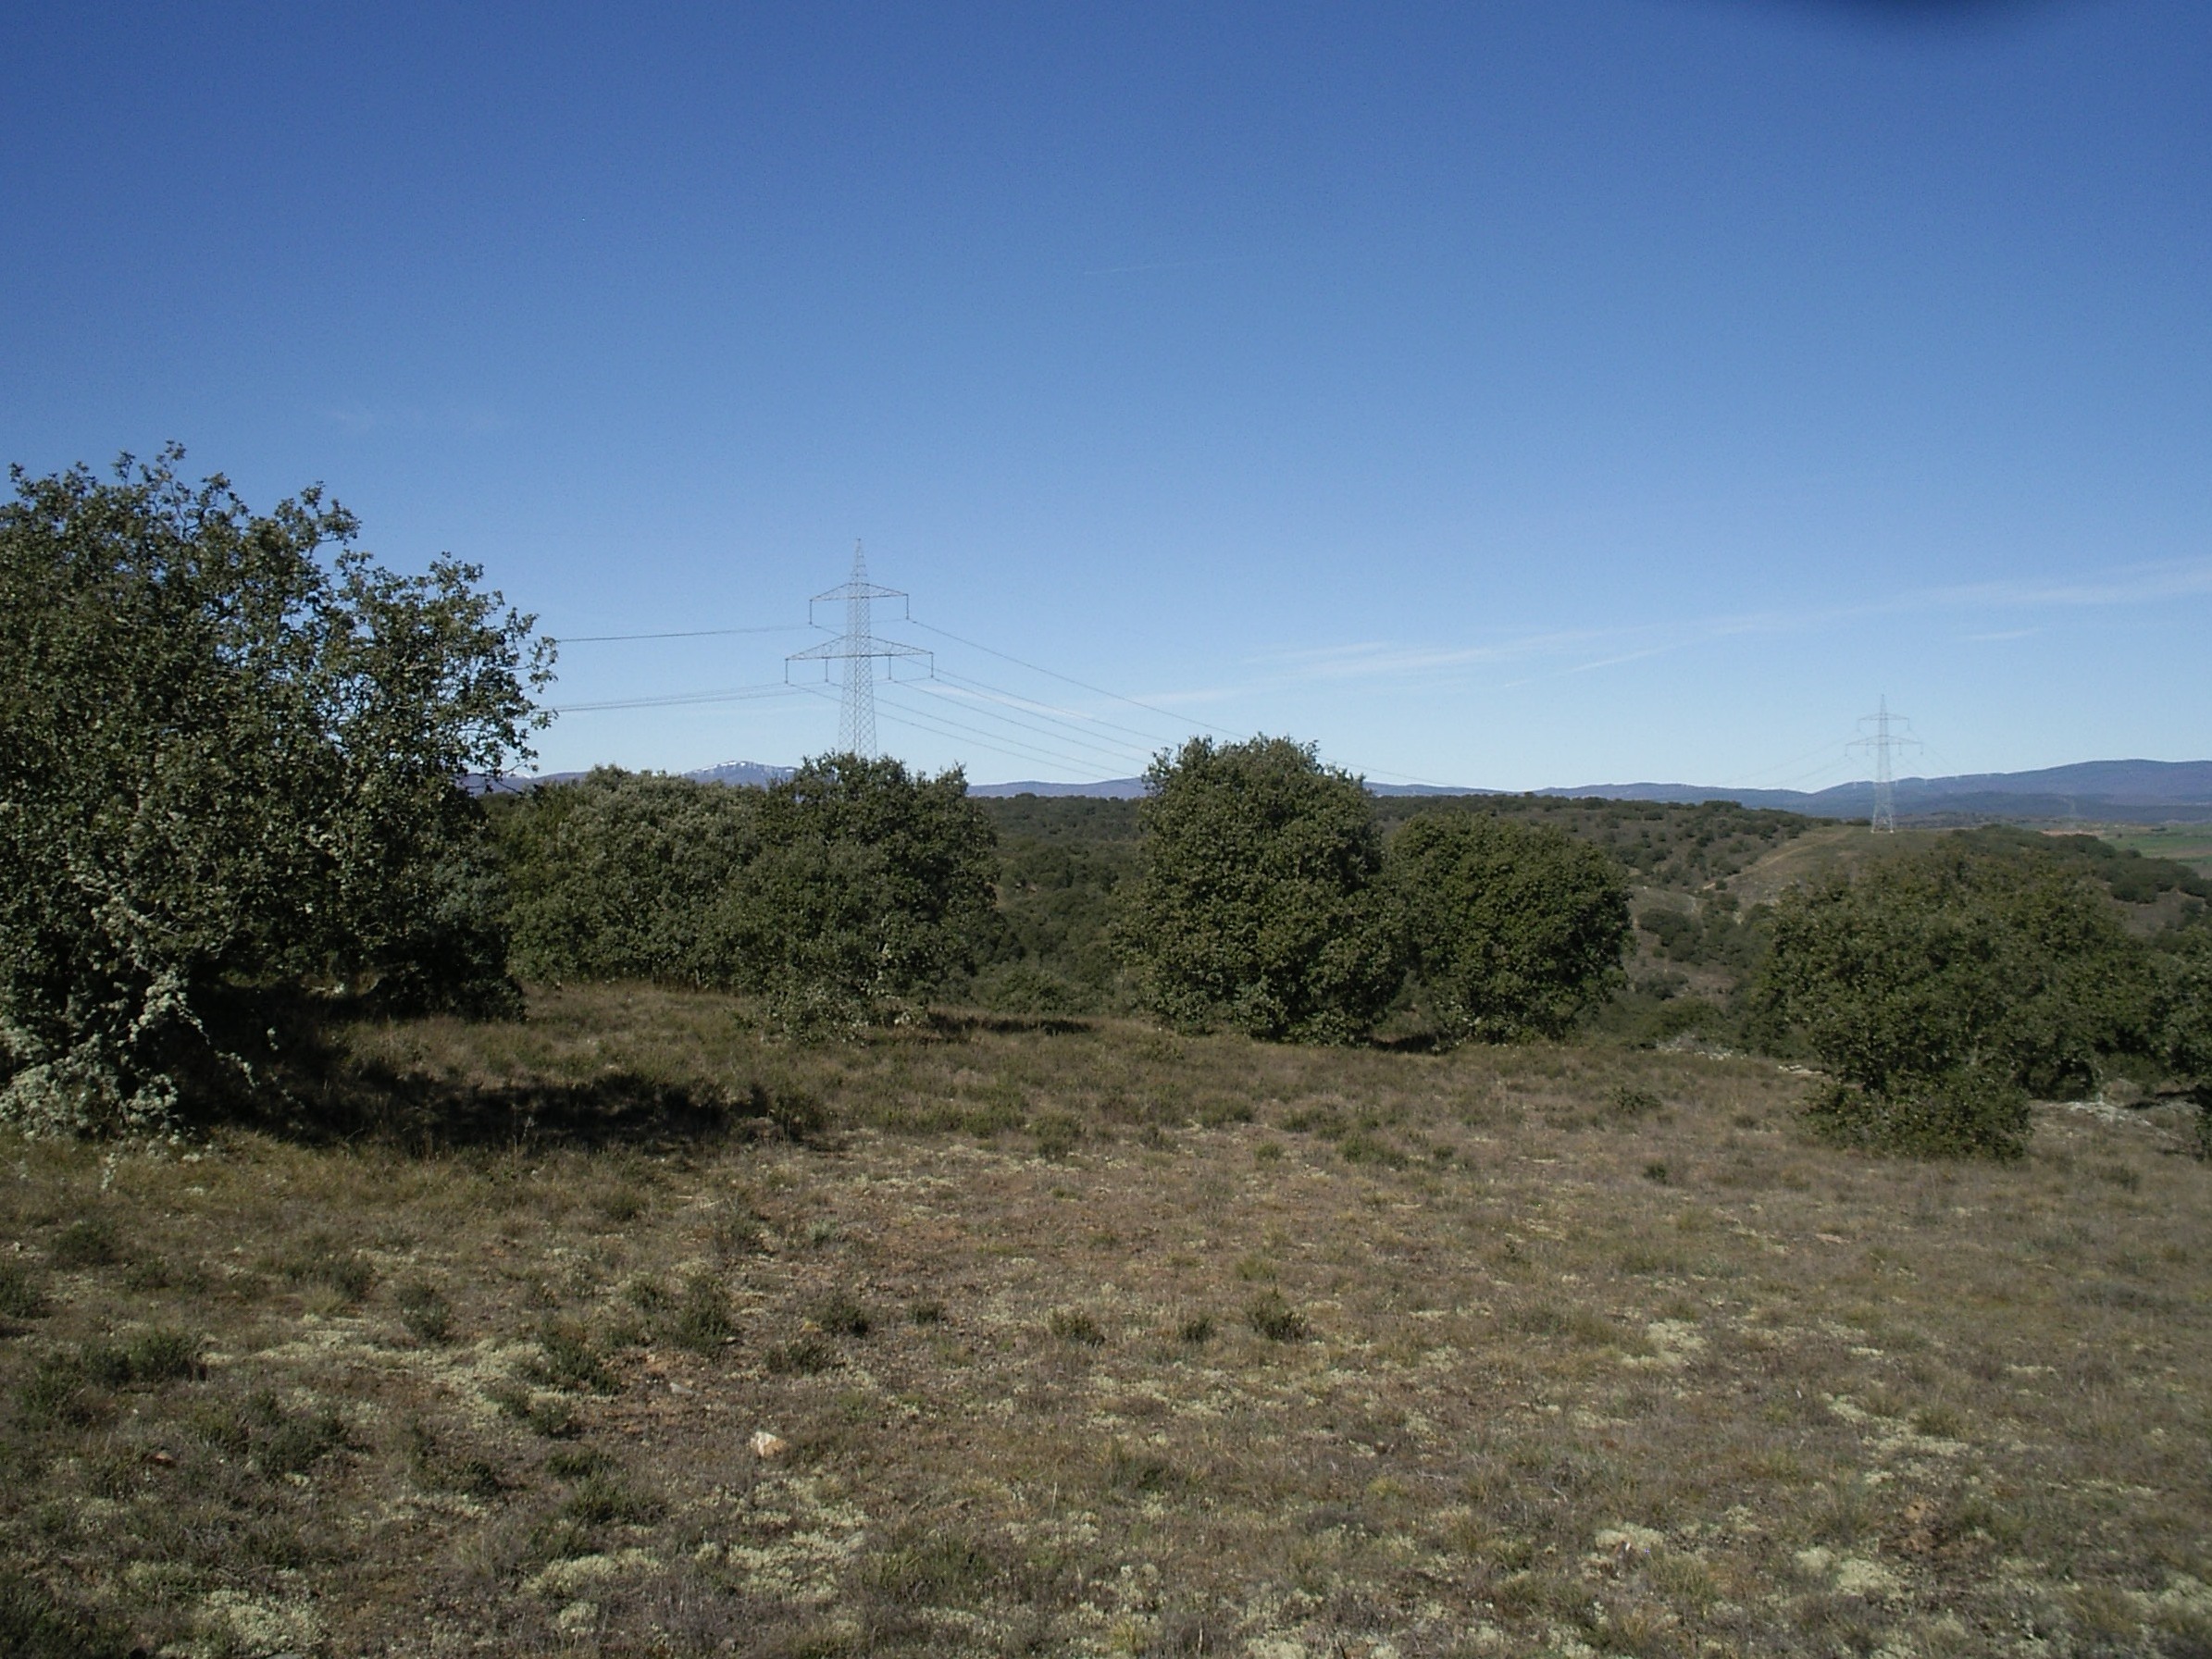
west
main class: Woodland
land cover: Broadleaved woodland
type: broadleaved evergreen forest
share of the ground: 10 - 25 %
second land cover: Grassland without tree/shrub cover
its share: > 75 %
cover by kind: herbaceous plants 80 %, broadleaved forest trees 15 %, shrubs 5 %
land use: Forestry
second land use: Agriculture (excluding fallow land and kitchen gardens)
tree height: > 5 m
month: March
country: ES
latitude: 42.4140
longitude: -6.0360
